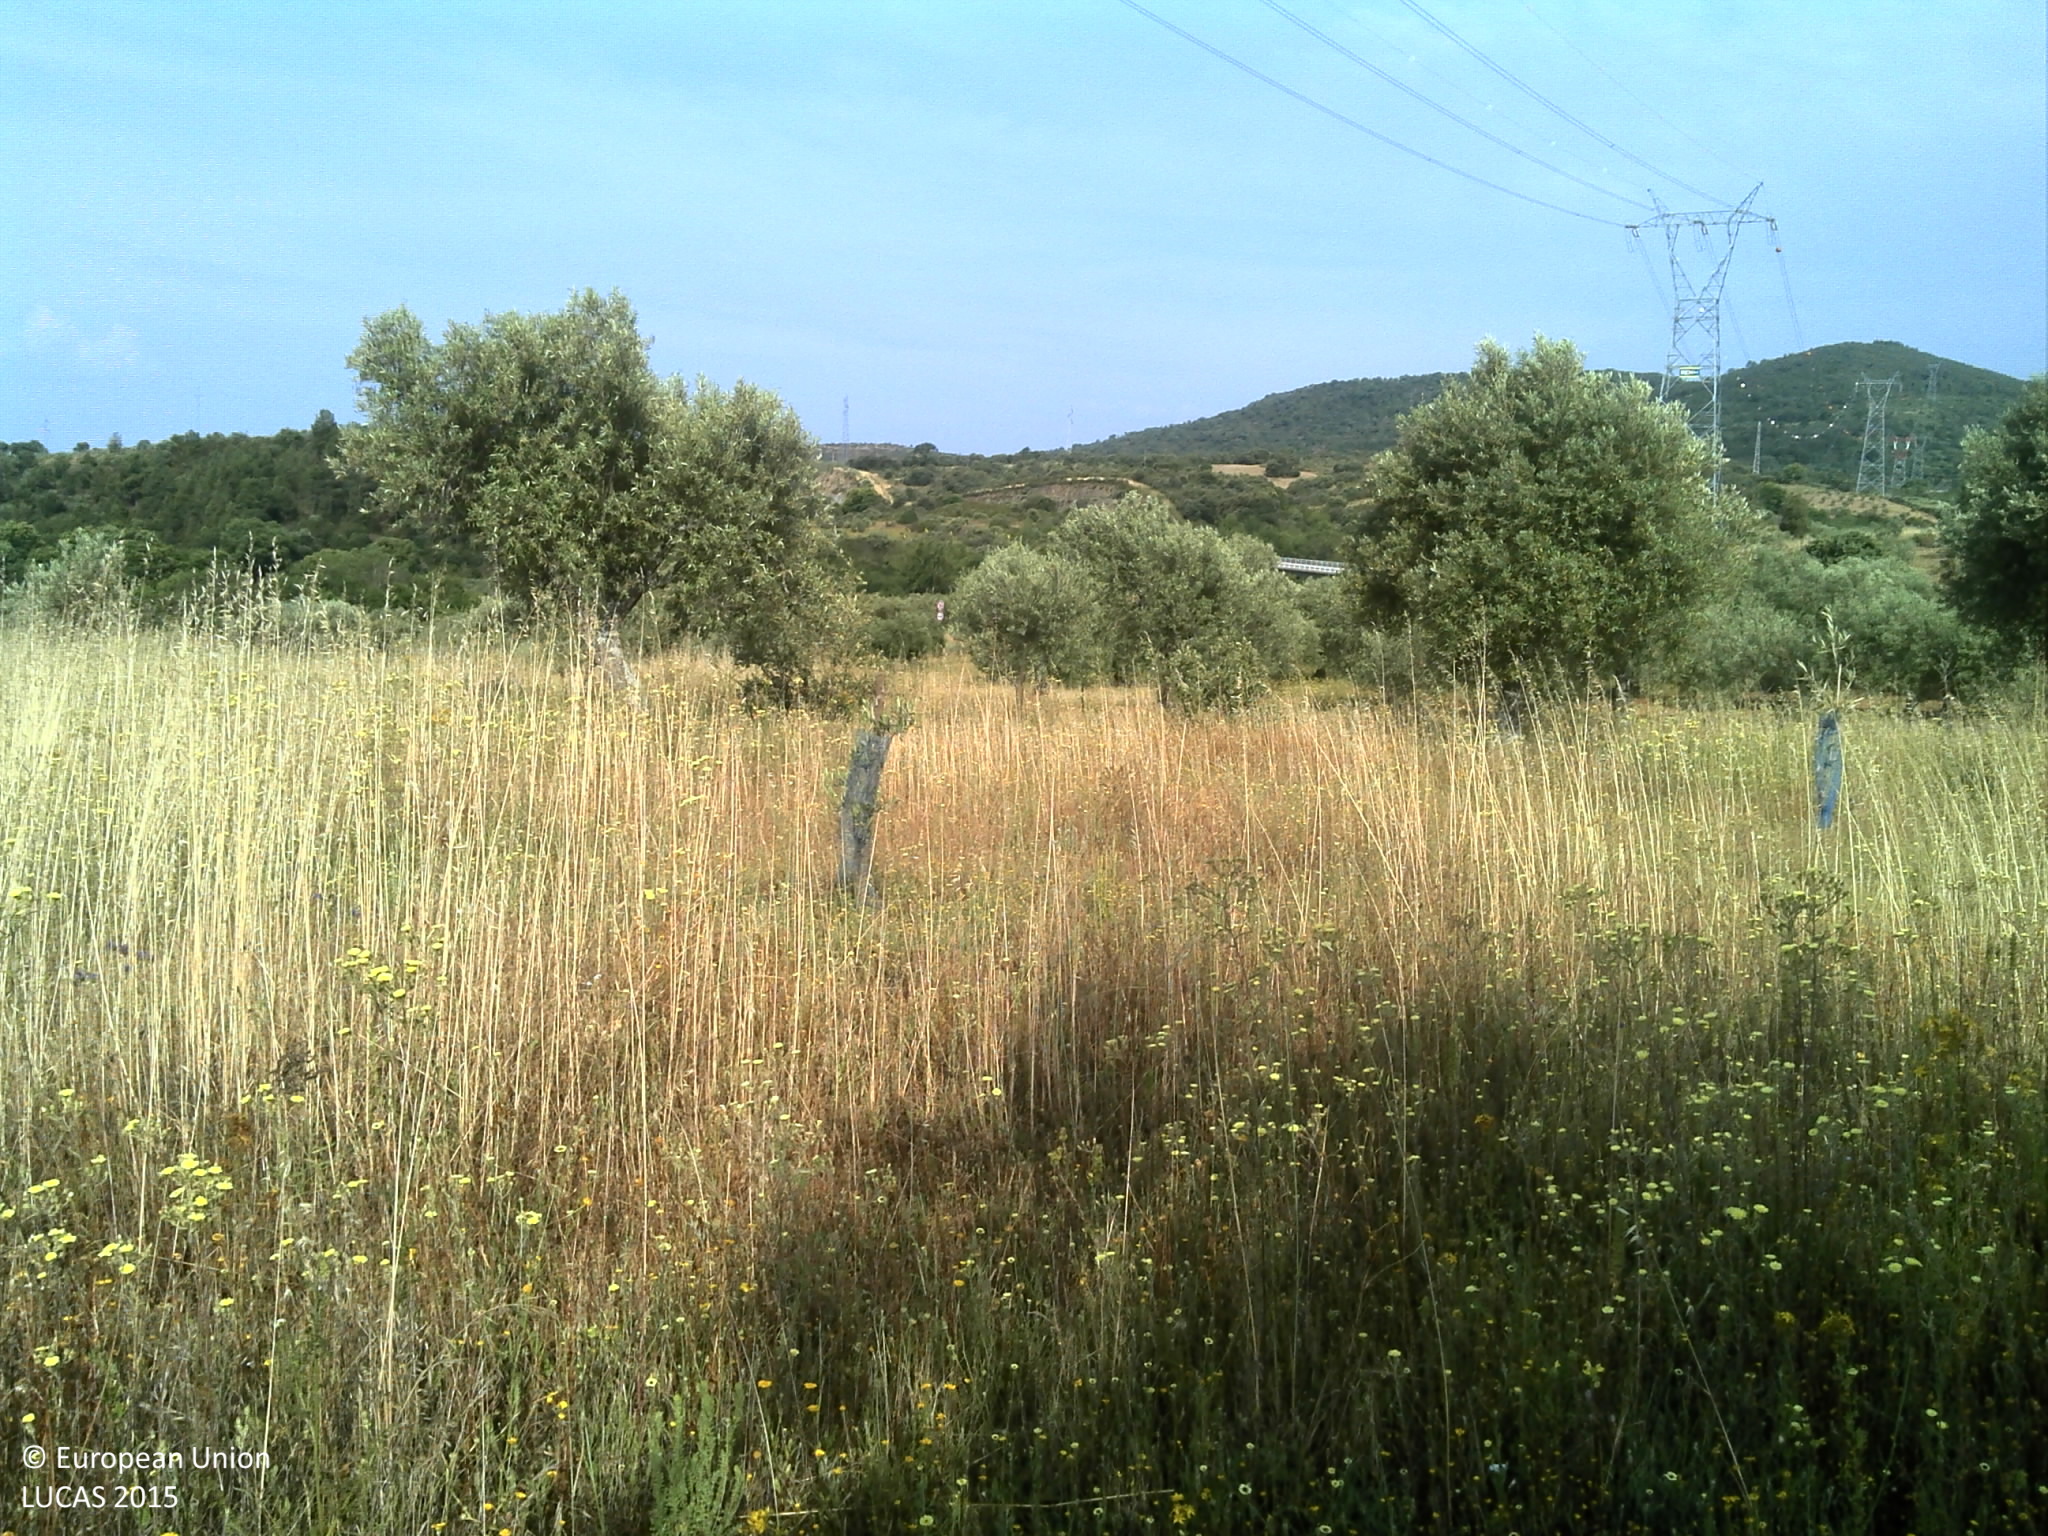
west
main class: Cropland
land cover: Olive groves
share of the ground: < 10 %
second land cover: Spontaneously vegetated surfaces
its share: 50 - 75 %
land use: Agriculture (excluding fallow land and kitchen gardens)
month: June
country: PT
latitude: 41.5219
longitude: -6.9751
